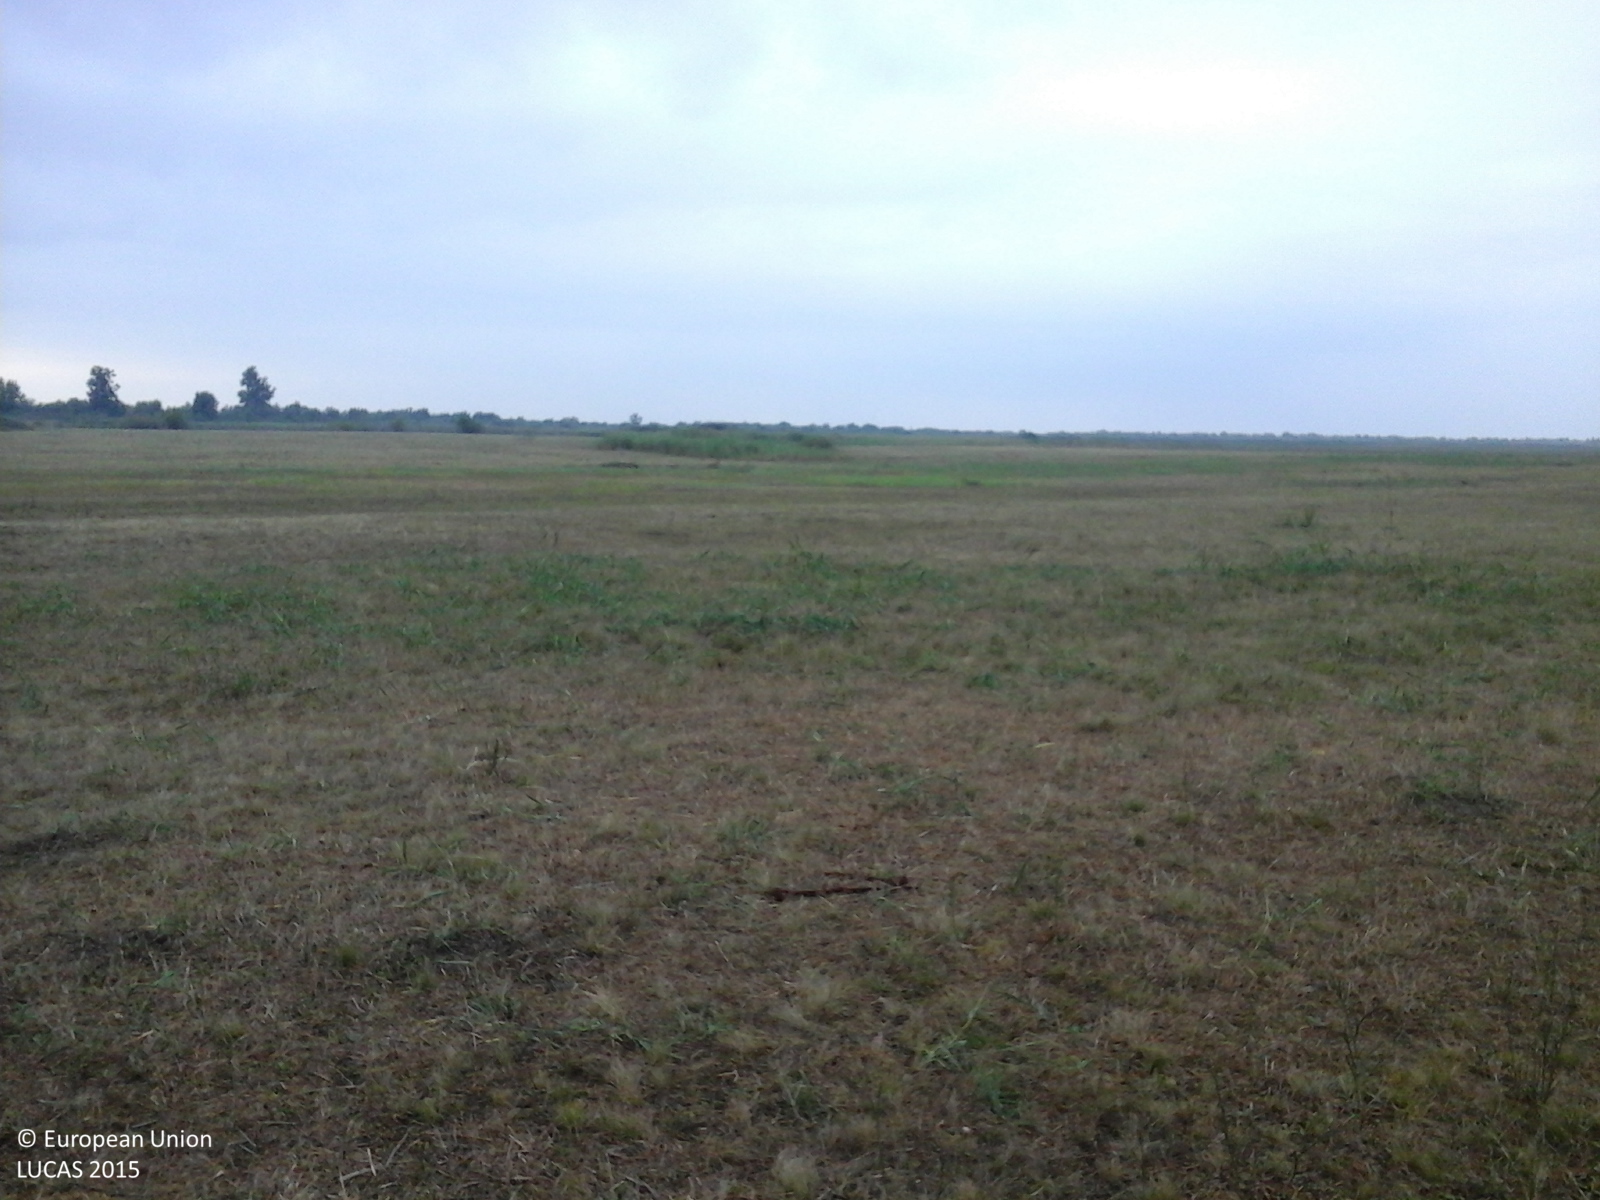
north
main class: Grassland
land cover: Grassland without tree/shrub cover
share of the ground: > 75 %
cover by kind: herbaceous plants 100 %
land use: Agriculture (excluding fallow land and kitchen gardens)
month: August
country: RO
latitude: 45.6727
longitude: 21.0032
